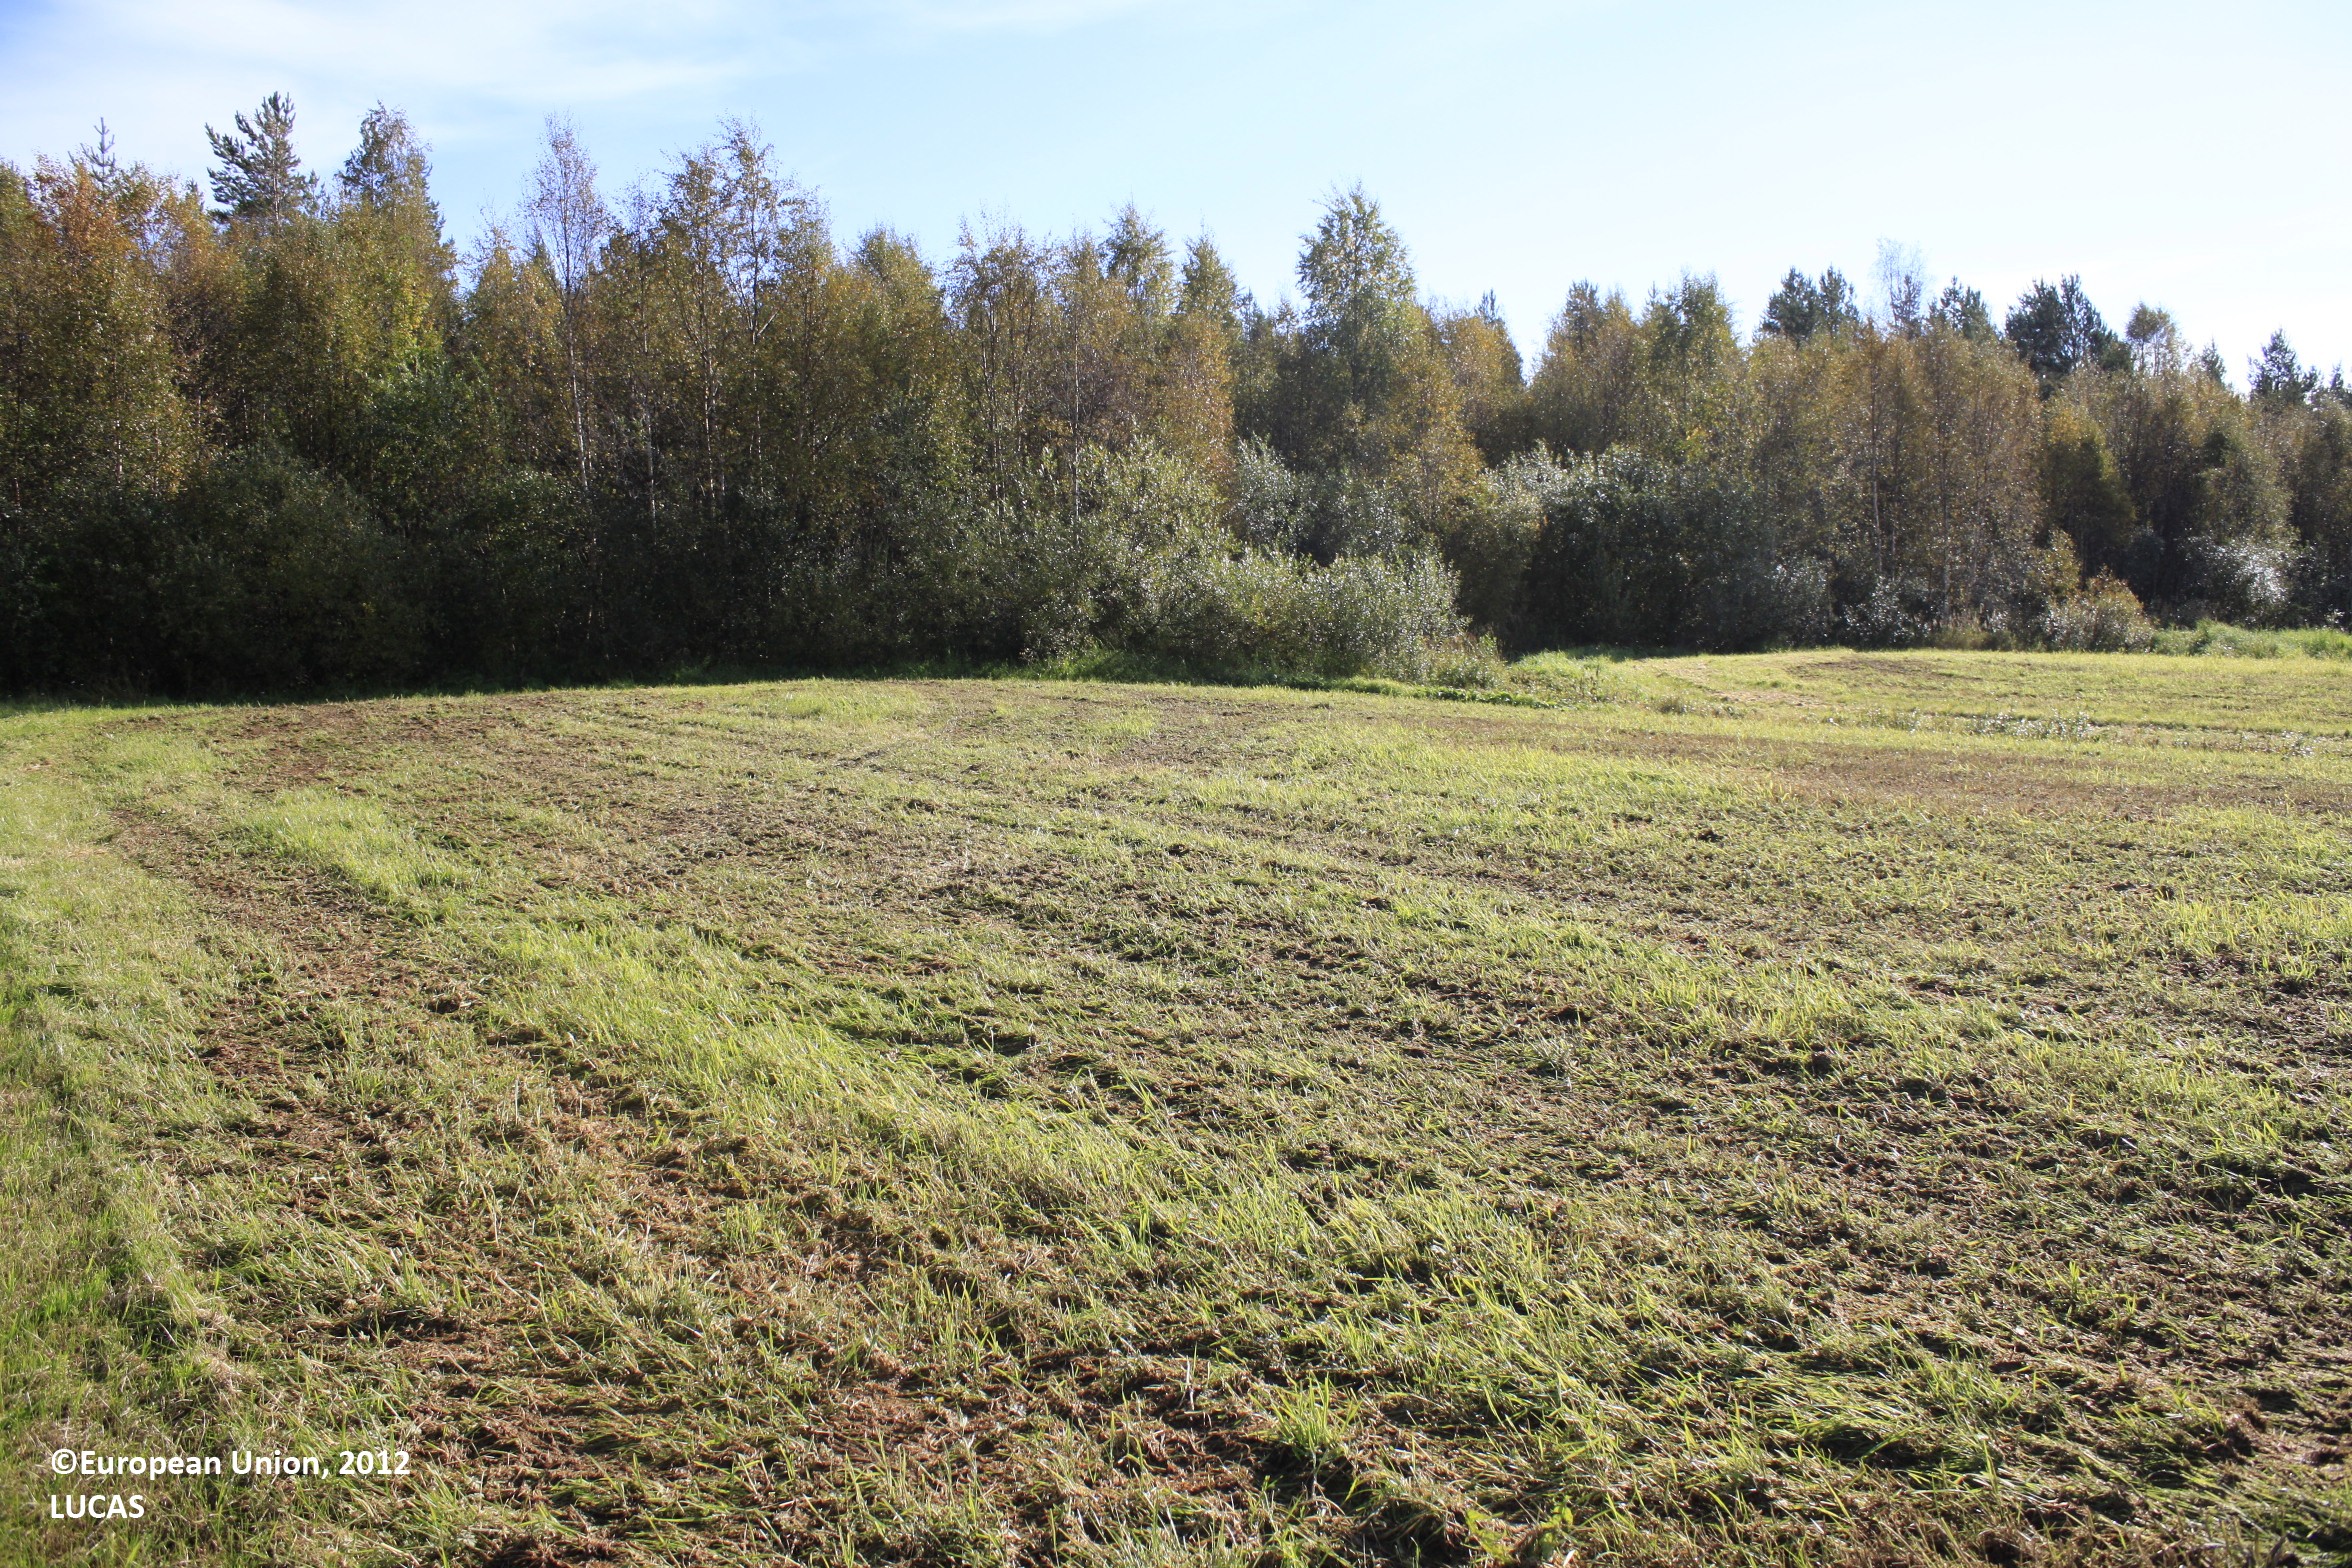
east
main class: Grassland
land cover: Grassland without tree/shrub cover
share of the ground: > 75 %
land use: Agriculture (excluding fallow land and kitchen gardens)
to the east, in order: Grassland without tree/shrub cover; Ditches and canals; Pine dominated mixed woodland; Ditches and canals; Pine dominated mixed woodland; Ditches and canals; Pine dominated mixed woodland; Ditches and canals; Broadleaved woodland; Ditches and canals; Broadleaved woodland
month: September
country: FI
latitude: 65.5888
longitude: 27.1848
